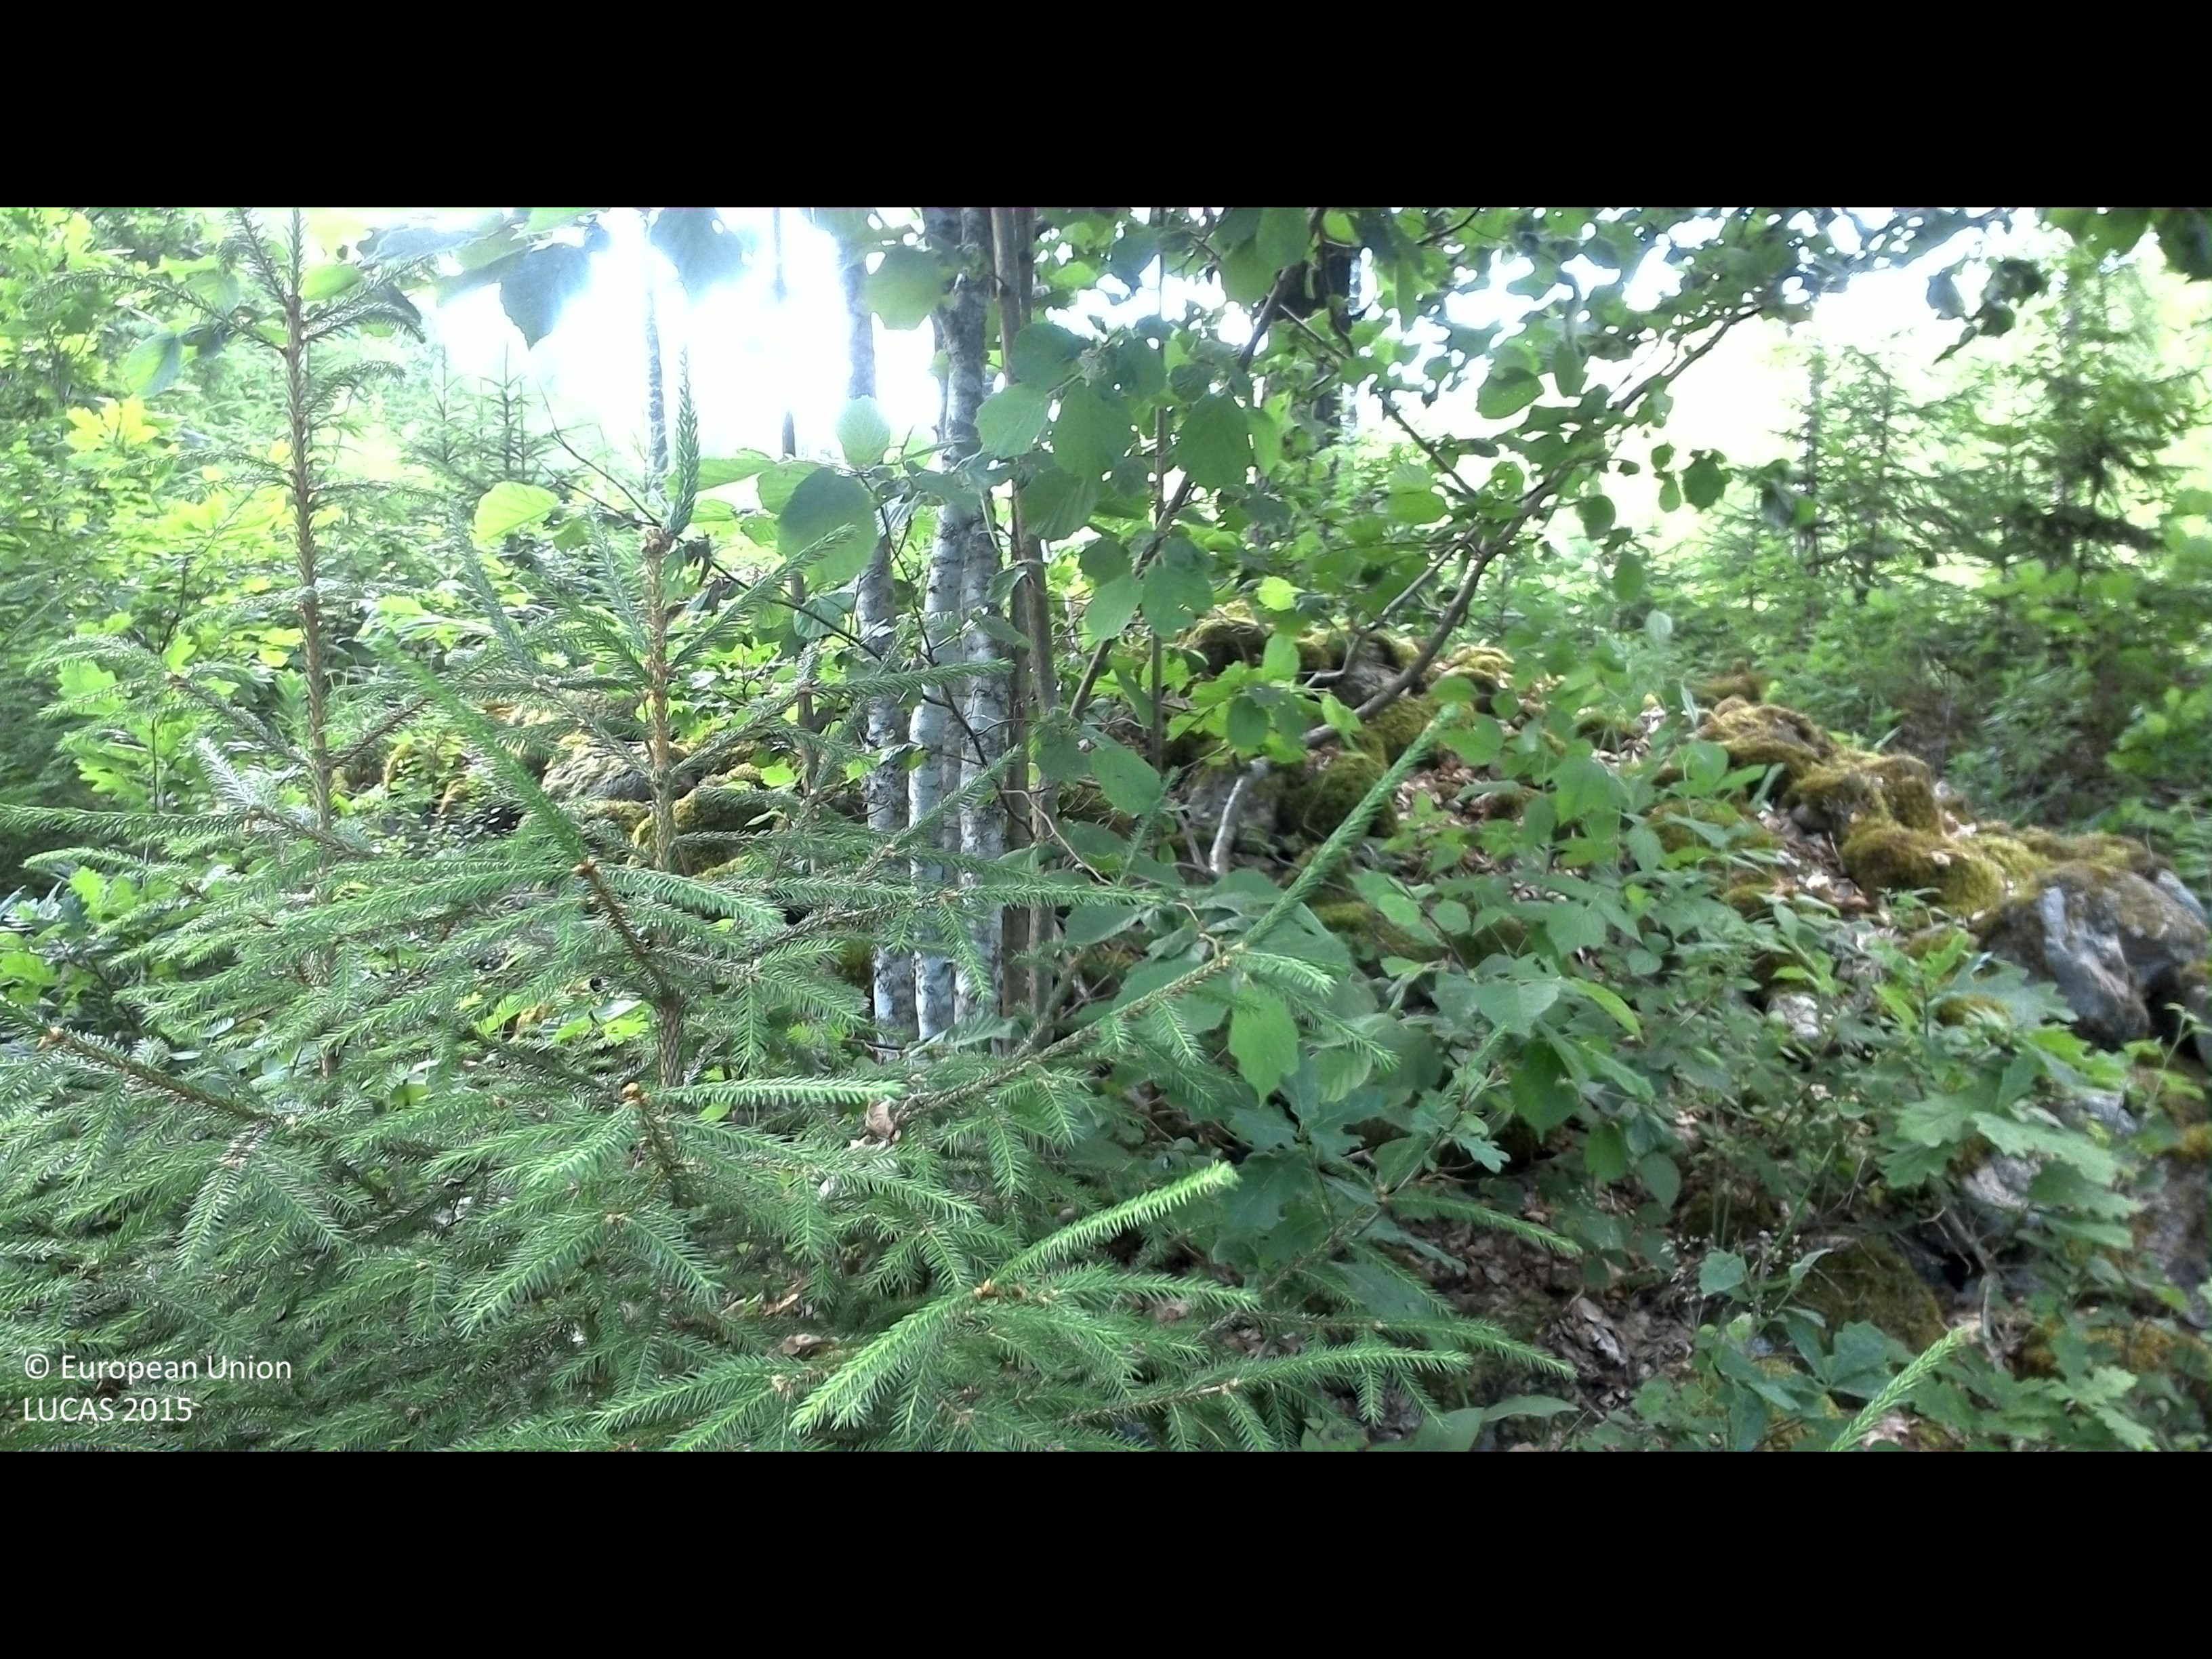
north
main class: Woodland
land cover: Broadleaved woodland
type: hemiboreal forest and nemoral coniferous forest and mixed broadleaved-coniferous forest
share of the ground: 50 - 75 %
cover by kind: broadleaved forest trees 65 %, shrubs 15 %, coniferous forest trees 10 %, herbaceous plants 10 %
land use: Forestry
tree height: > 5 m
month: July
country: SE
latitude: 56.4490
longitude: 15.0438
